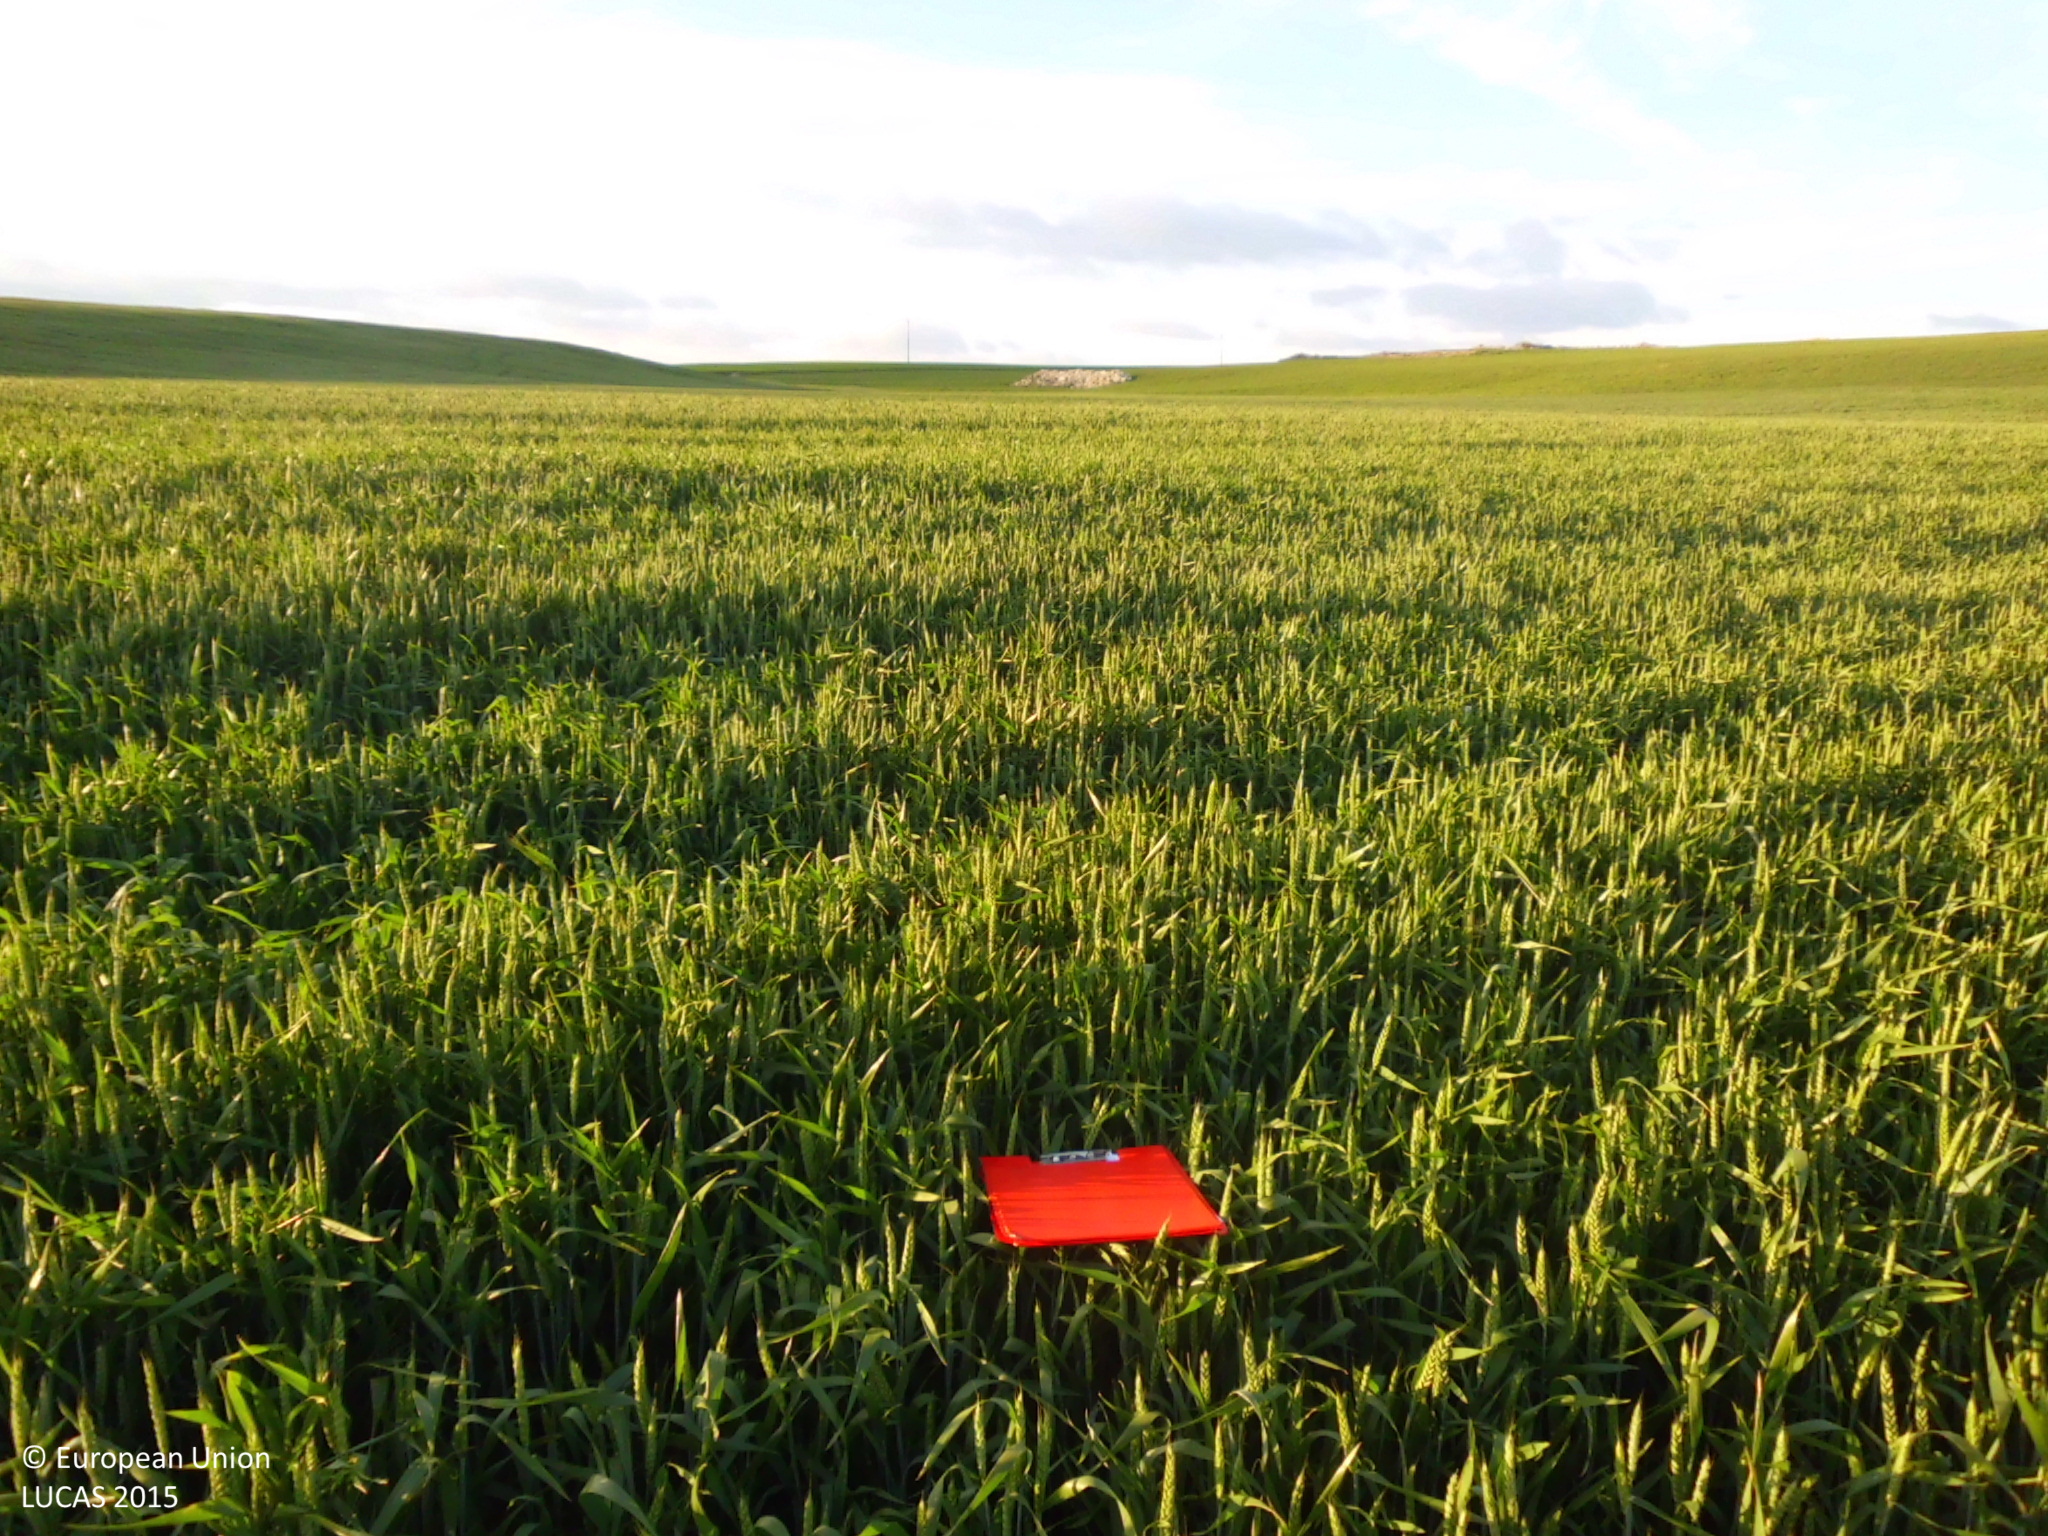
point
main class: Cropland
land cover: Common wheat
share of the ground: > 75 %
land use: Agriculture (excluding fallow land and kitchen gardens)
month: May
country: ES
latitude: 42.4600
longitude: -3.8916
